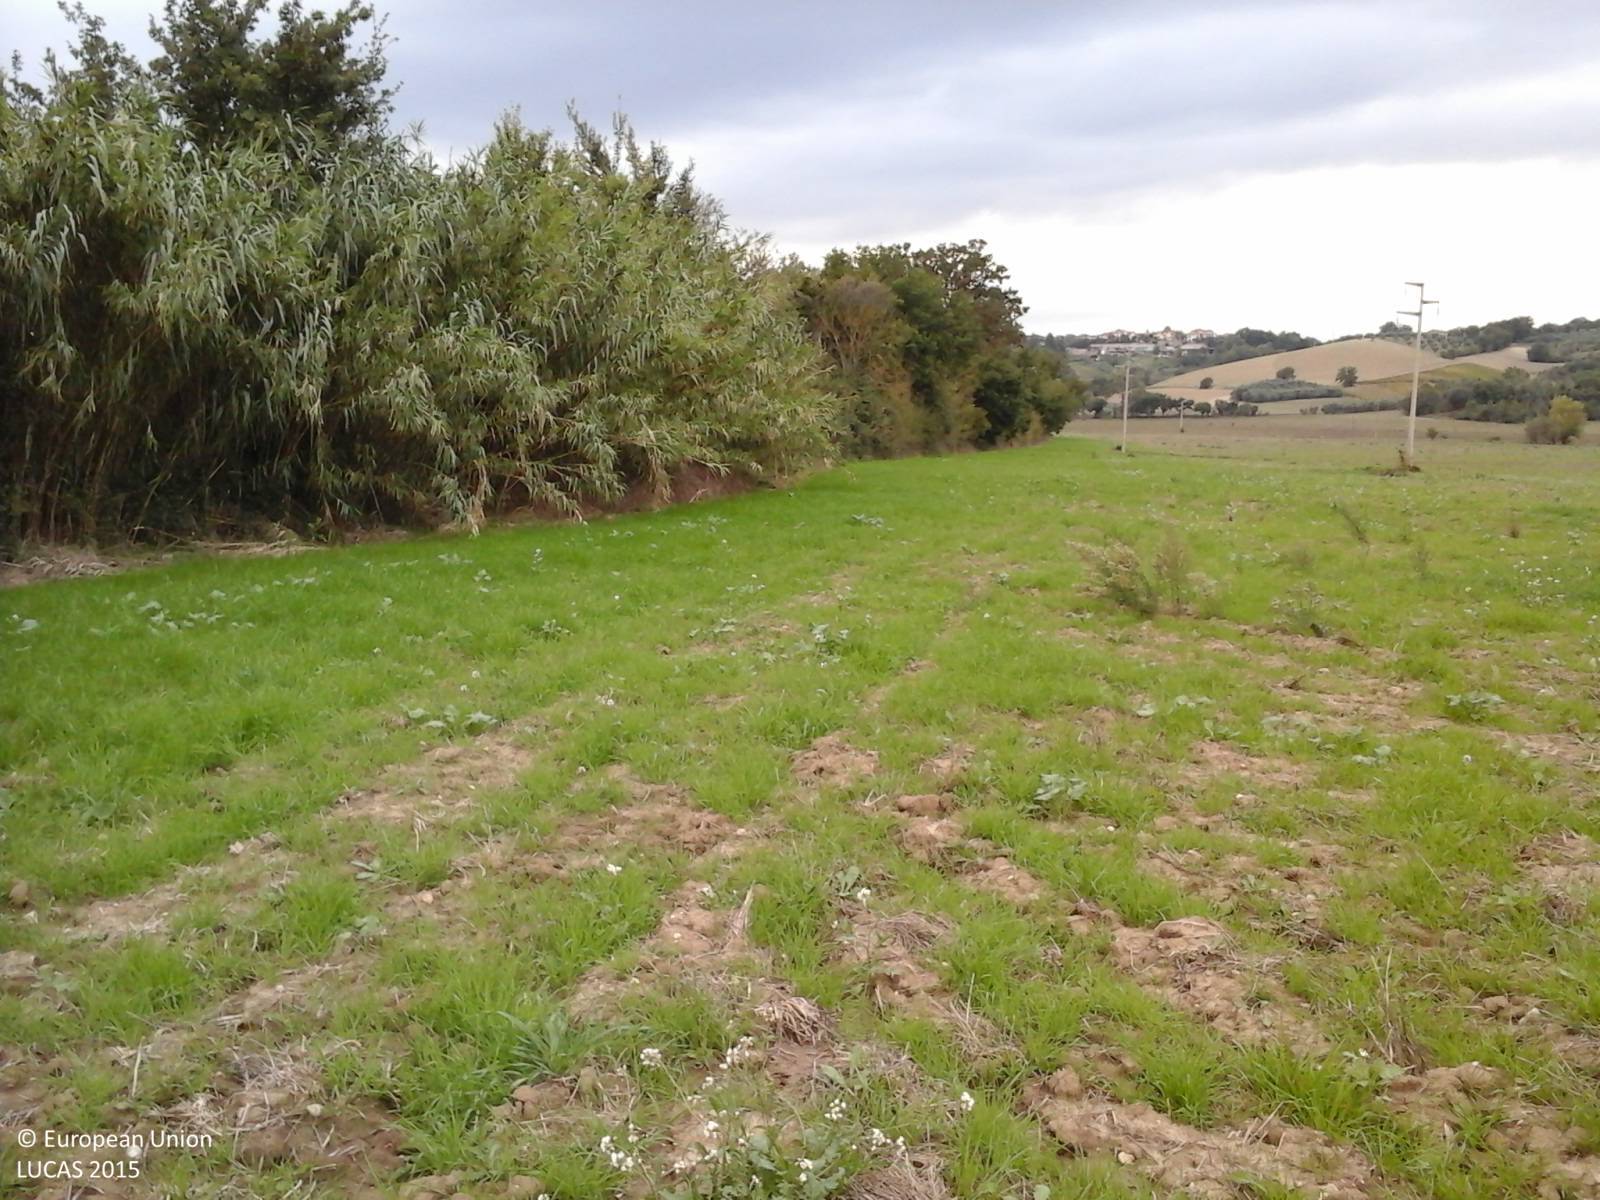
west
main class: Grassland
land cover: Spontaneously vegetated surfaces
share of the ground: > 75 %
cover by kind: herbaceous plants 70 %, unconsolidated bare surface 30 %
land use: Agriculture (excluding fallow land and kitchen gardens)
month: October
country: IT
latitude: 42.6477
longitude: 12.2249
